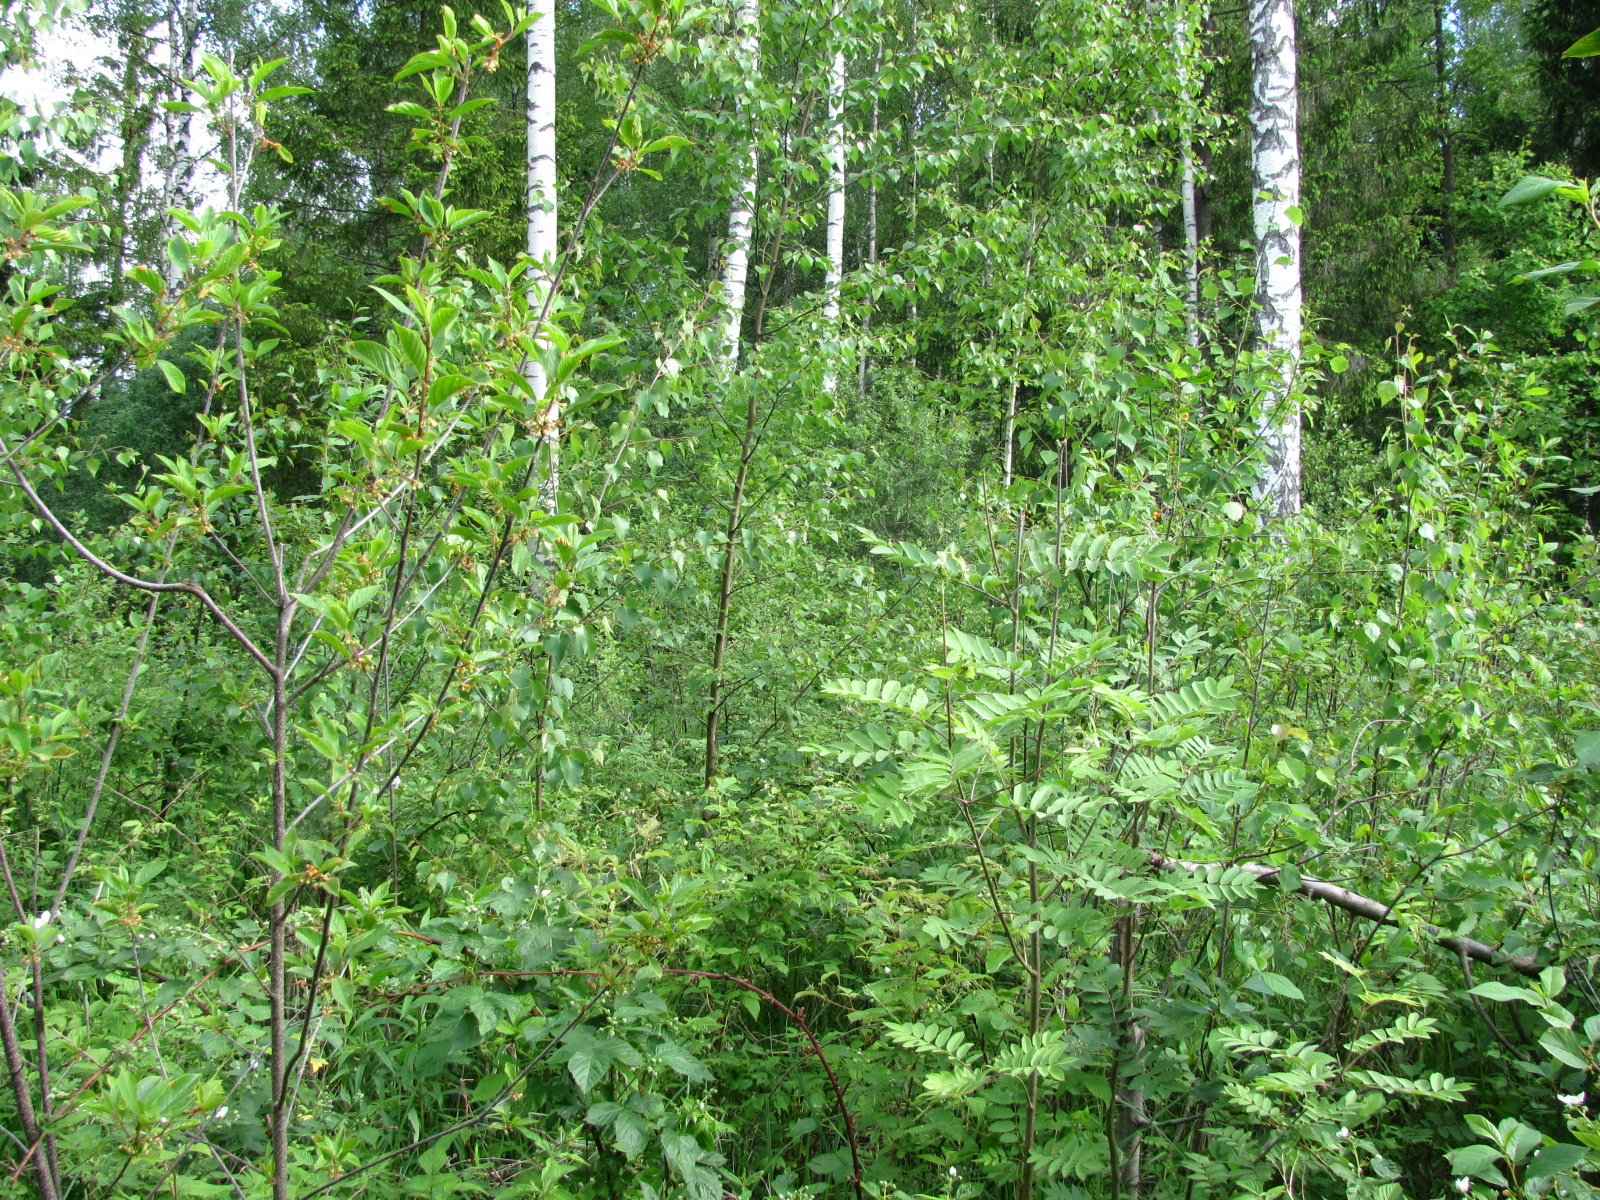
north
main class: Woodland
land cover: Broadleaved woodland
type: non-riverine alder, birch or aspen forest
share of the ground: 50 - 75 %
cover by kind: broadleaved forest trees 70 %, shrubs 30 %
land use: Forestry
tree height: < 5 m
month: June
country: LV
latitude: 56.7040
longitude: 23.9167
